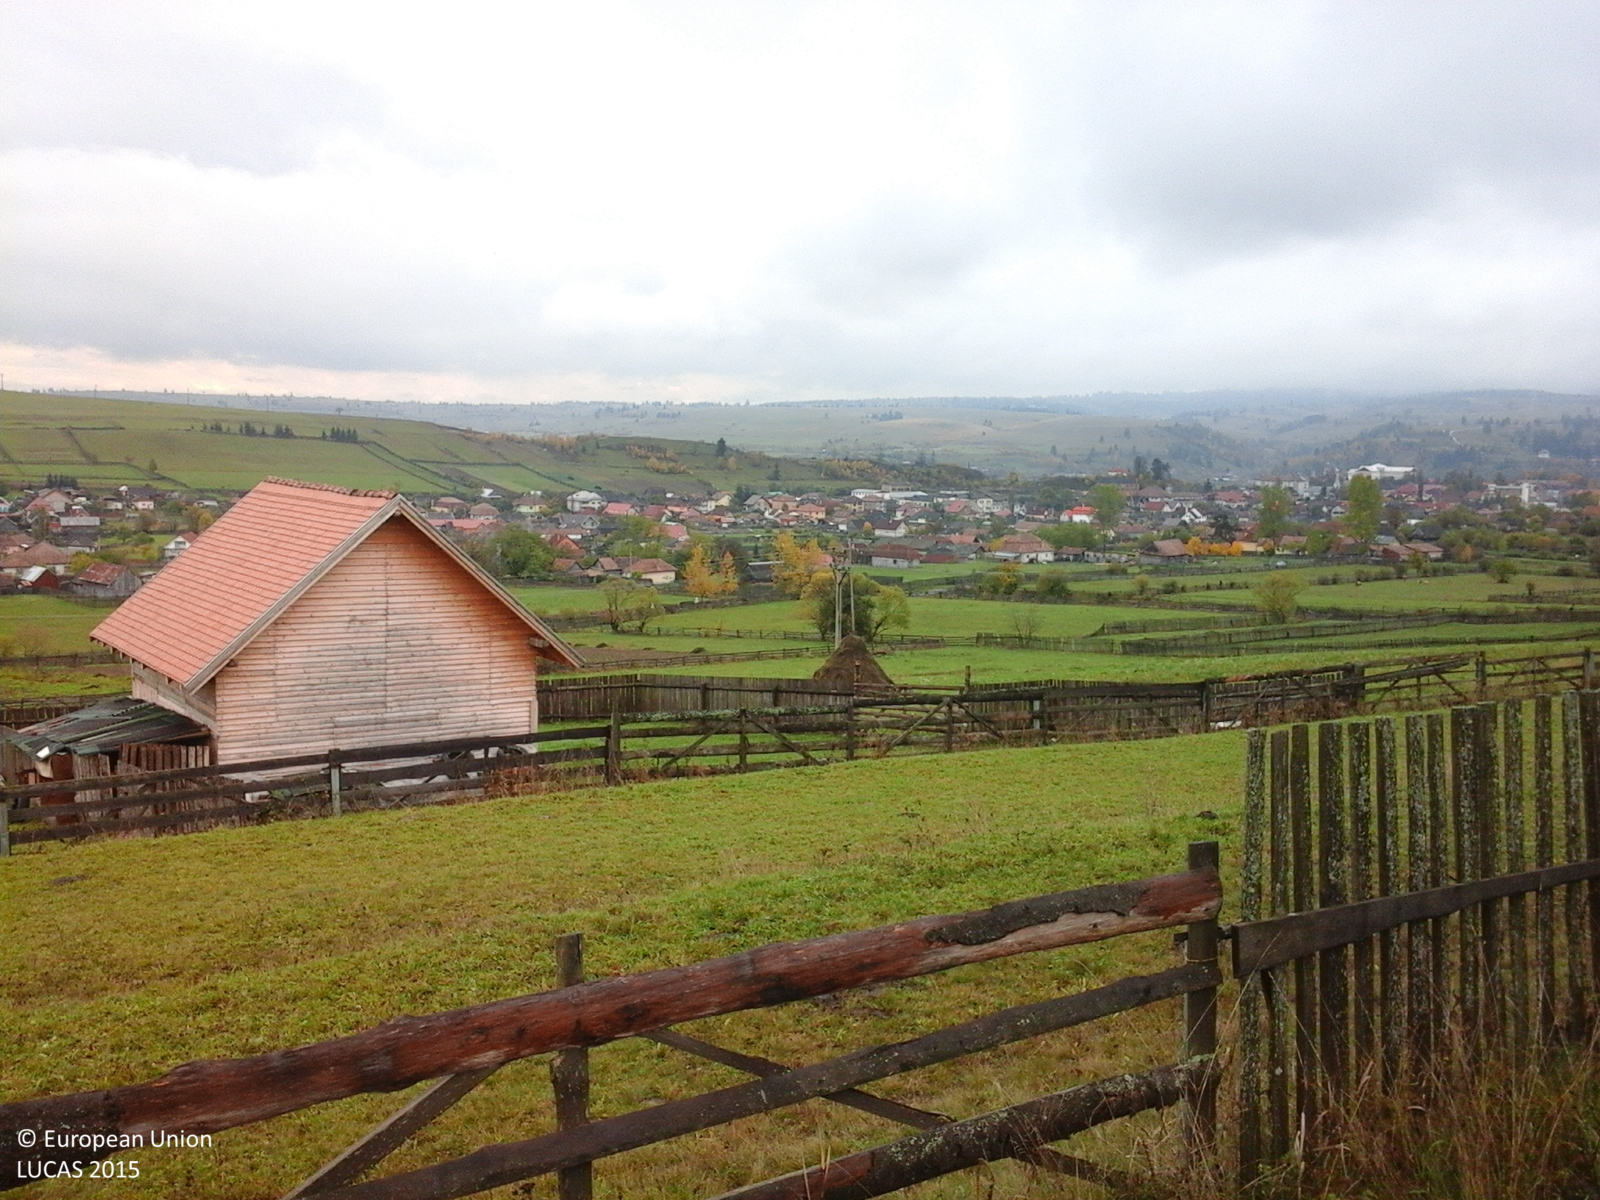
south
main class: Grassland
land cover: Grassland without tree/shrub cover
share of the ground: > 75 %
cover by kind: herbaceous plants 100 %
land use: Agriculture (excluding fallow land and kitchen gardens)
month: October
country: RO
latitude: 46.9373
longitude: 25.3594
